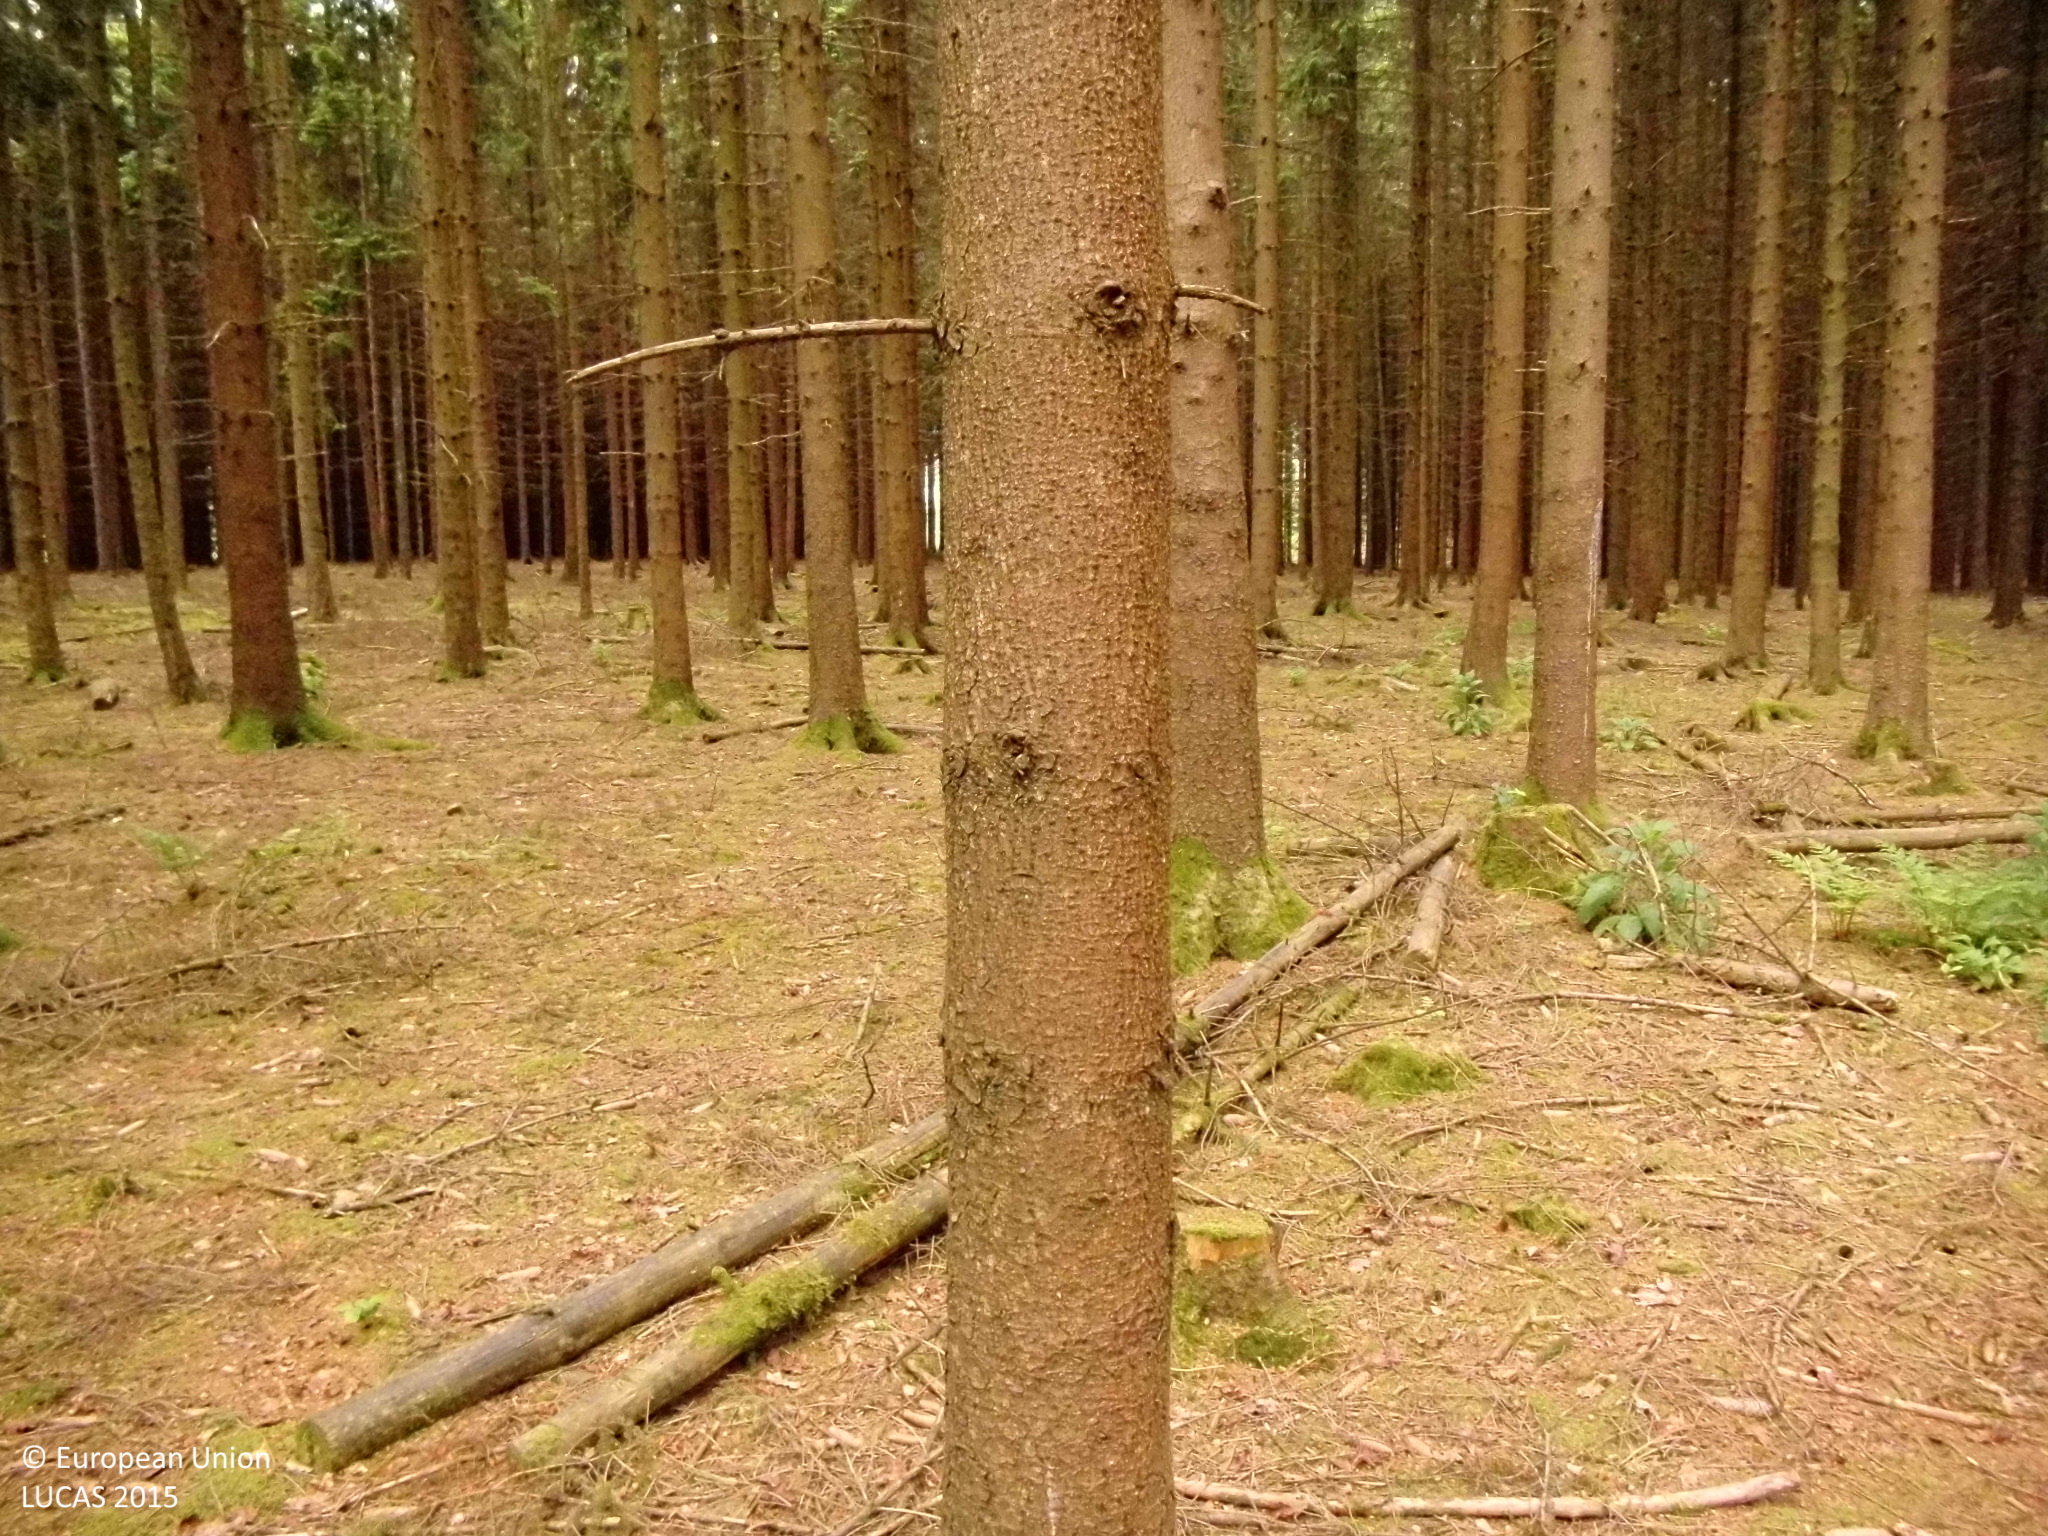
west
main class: Woodland
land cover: Spruce dominated coniferous woodland
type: hemiboreal forest and nemoral coniferous forest and mixed broadleaved-coniferous forest
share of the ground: > 75 %
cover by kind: coniferous forest trees 80 %, unconsolidated bare surface 15 %, herbaceous plants 5 %
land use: Forestry
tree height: > 5 m
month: May
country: DE
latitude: 50.9306
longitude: 7.5103
